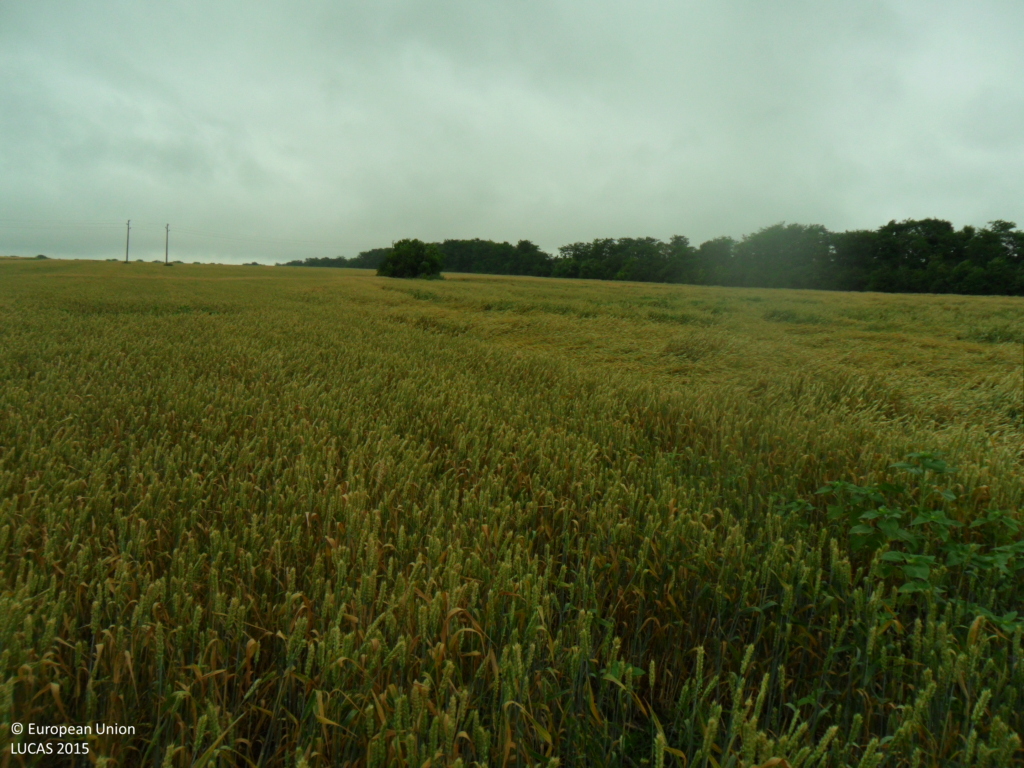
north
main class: Cropland
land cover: Common wheat
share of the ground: > 75 %
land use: Agriculture (excluding fallow land and kitchen gardens)
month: June
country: BG
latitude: 43.3222
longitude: 26.9968
